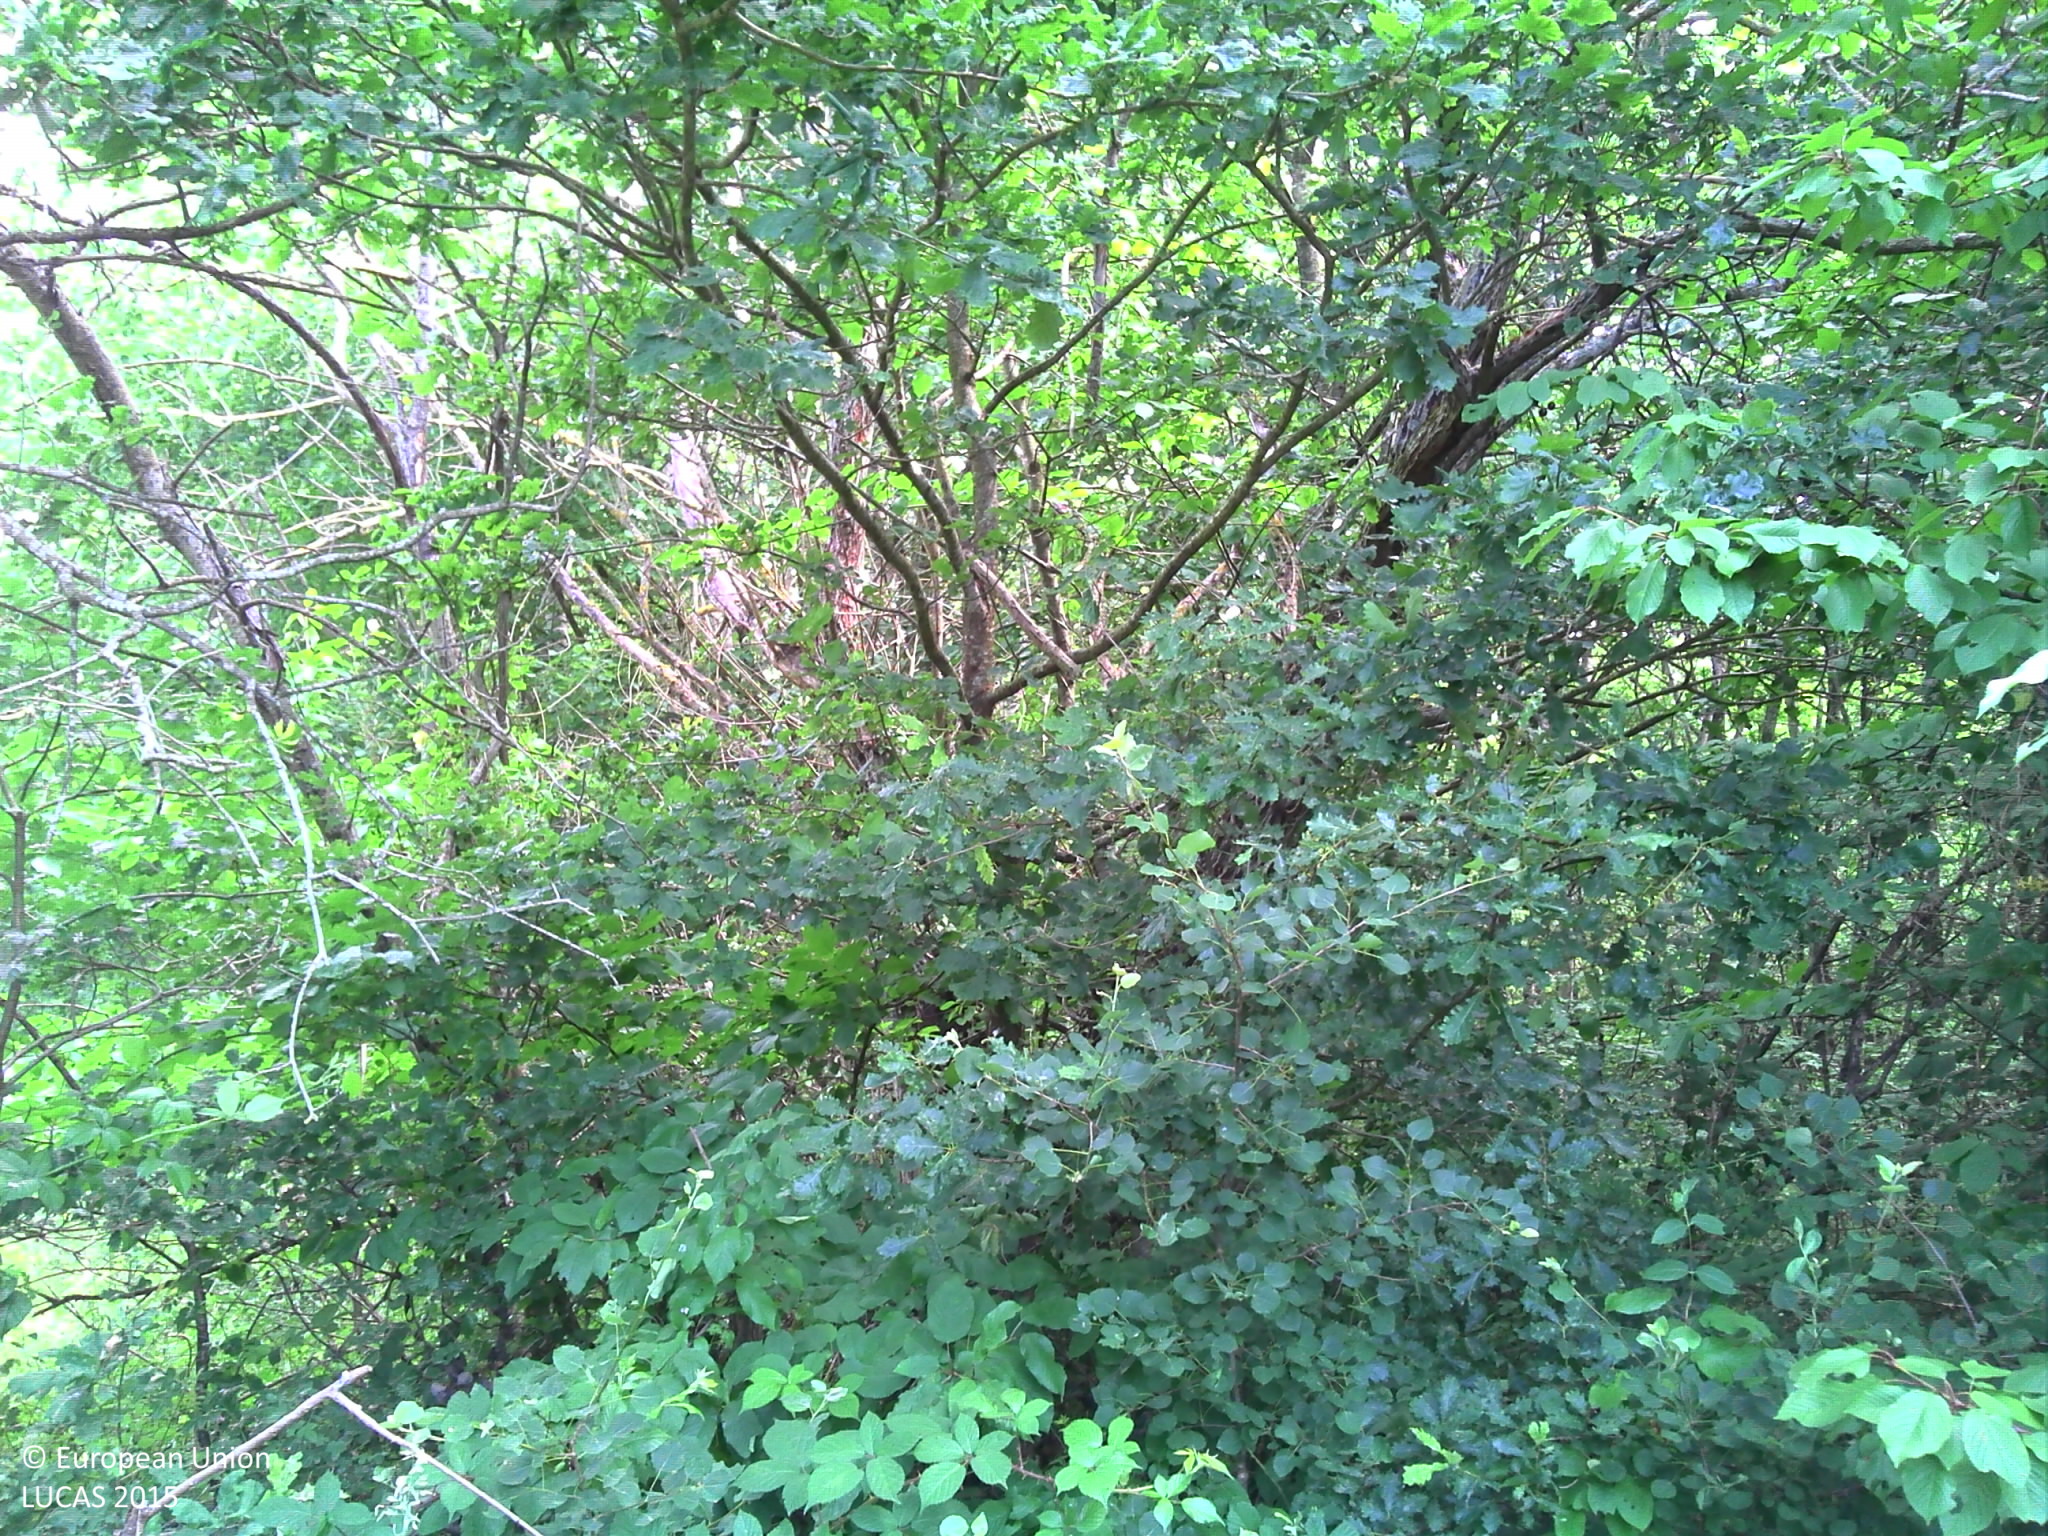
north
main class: Woodland
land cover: Broadleaved woodland
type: mesophytic deciduous forest
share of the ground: > 75 %
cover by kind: broadleaved forest trees 90 %, shrubs 5 %, herbaceous plants 5 %
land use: Forestry
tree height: > 5 m
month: June
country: FR
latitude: 46.3745
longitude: 3.2773
